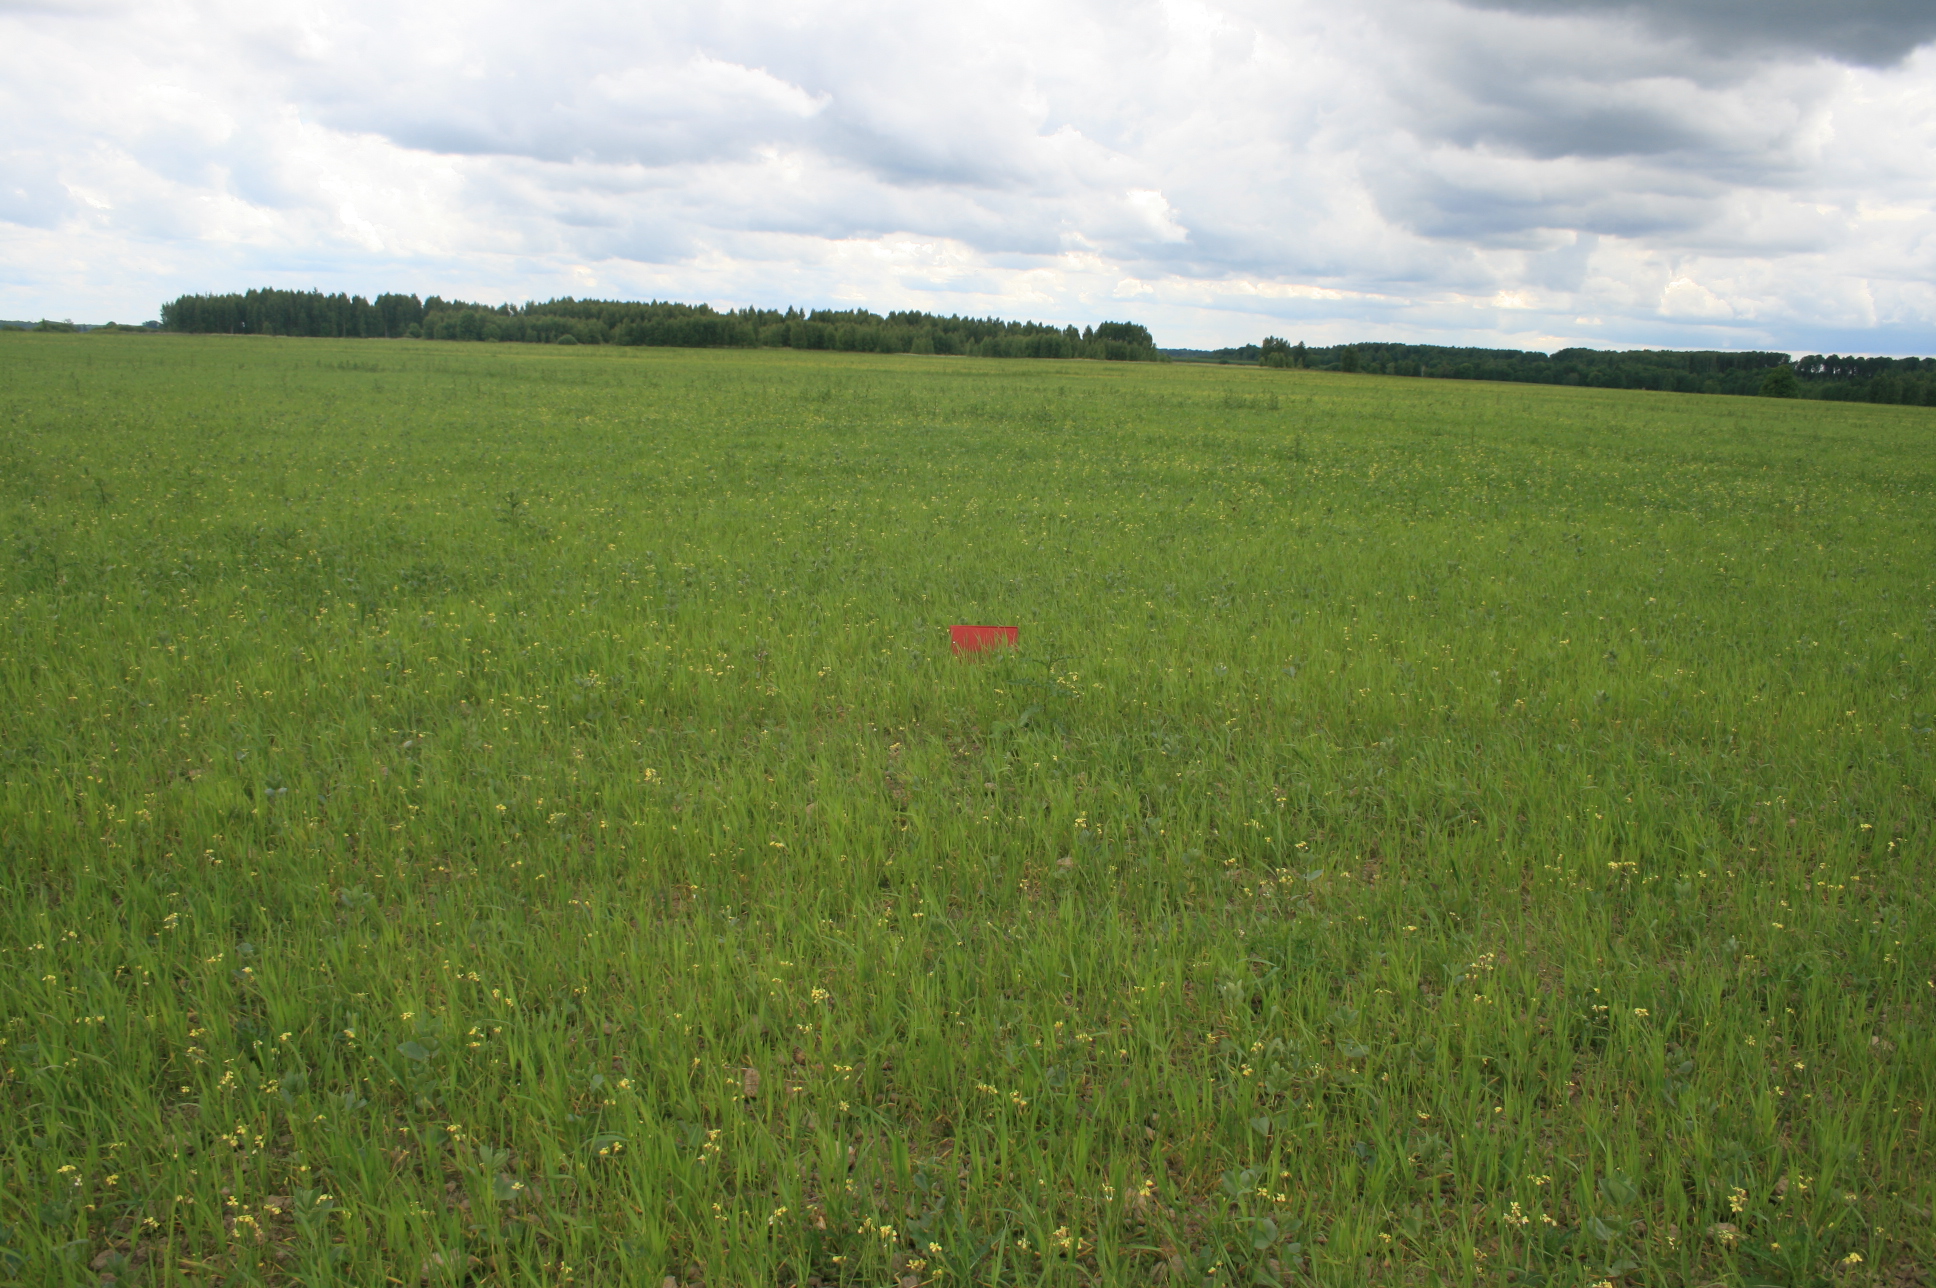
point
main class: Cropland
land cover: Other leguminous and mixtures for fodder
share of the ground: > 75 %
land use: Agriculture (excluding fallow land and kitchen gardens)
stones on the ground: < 10 %
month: June
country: LT
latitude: 55.3905
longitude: 22.3249
